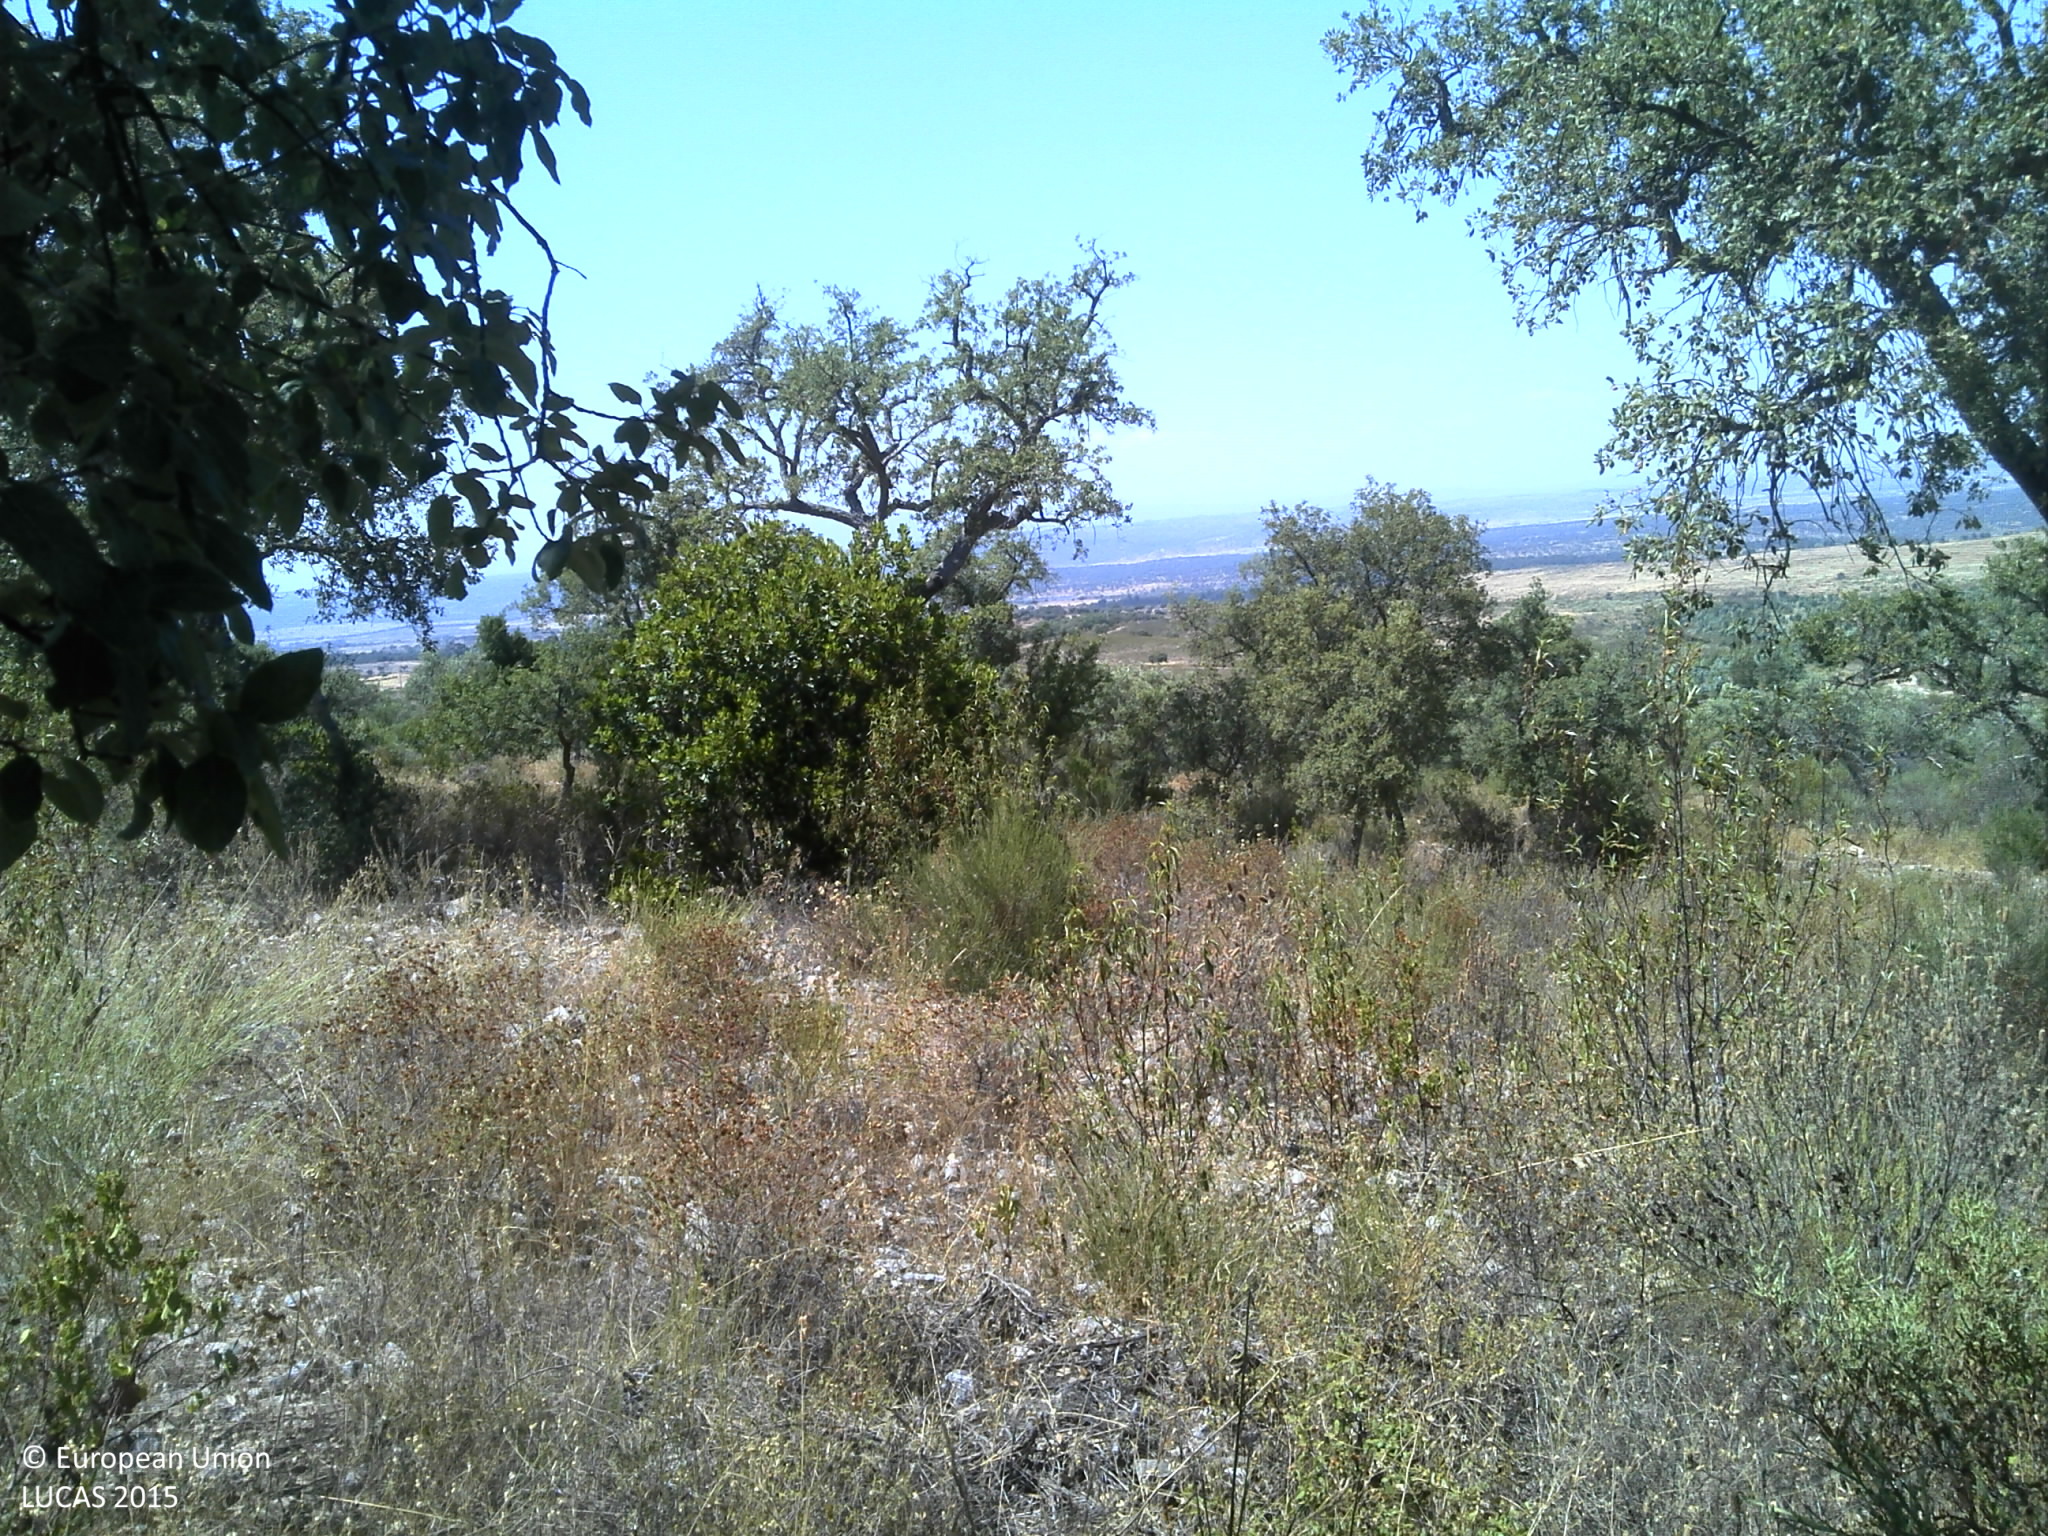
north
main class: Woodland
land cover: Broadleaved woodland
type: broadleaved evergreen forest
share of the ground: 25 - 50 %
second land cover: Grassland without tree/shrub cover
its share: 50 - 75 %
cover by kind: herbaceous plants 50 %, broadleaved forest trees 45 %, shrubs 5 %
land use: Forestry
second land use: Agriculture (excluding fallow land and kitchen gardens)
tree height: > 5 m
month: June
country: PT
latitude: 39.7492
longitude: -7.3075
